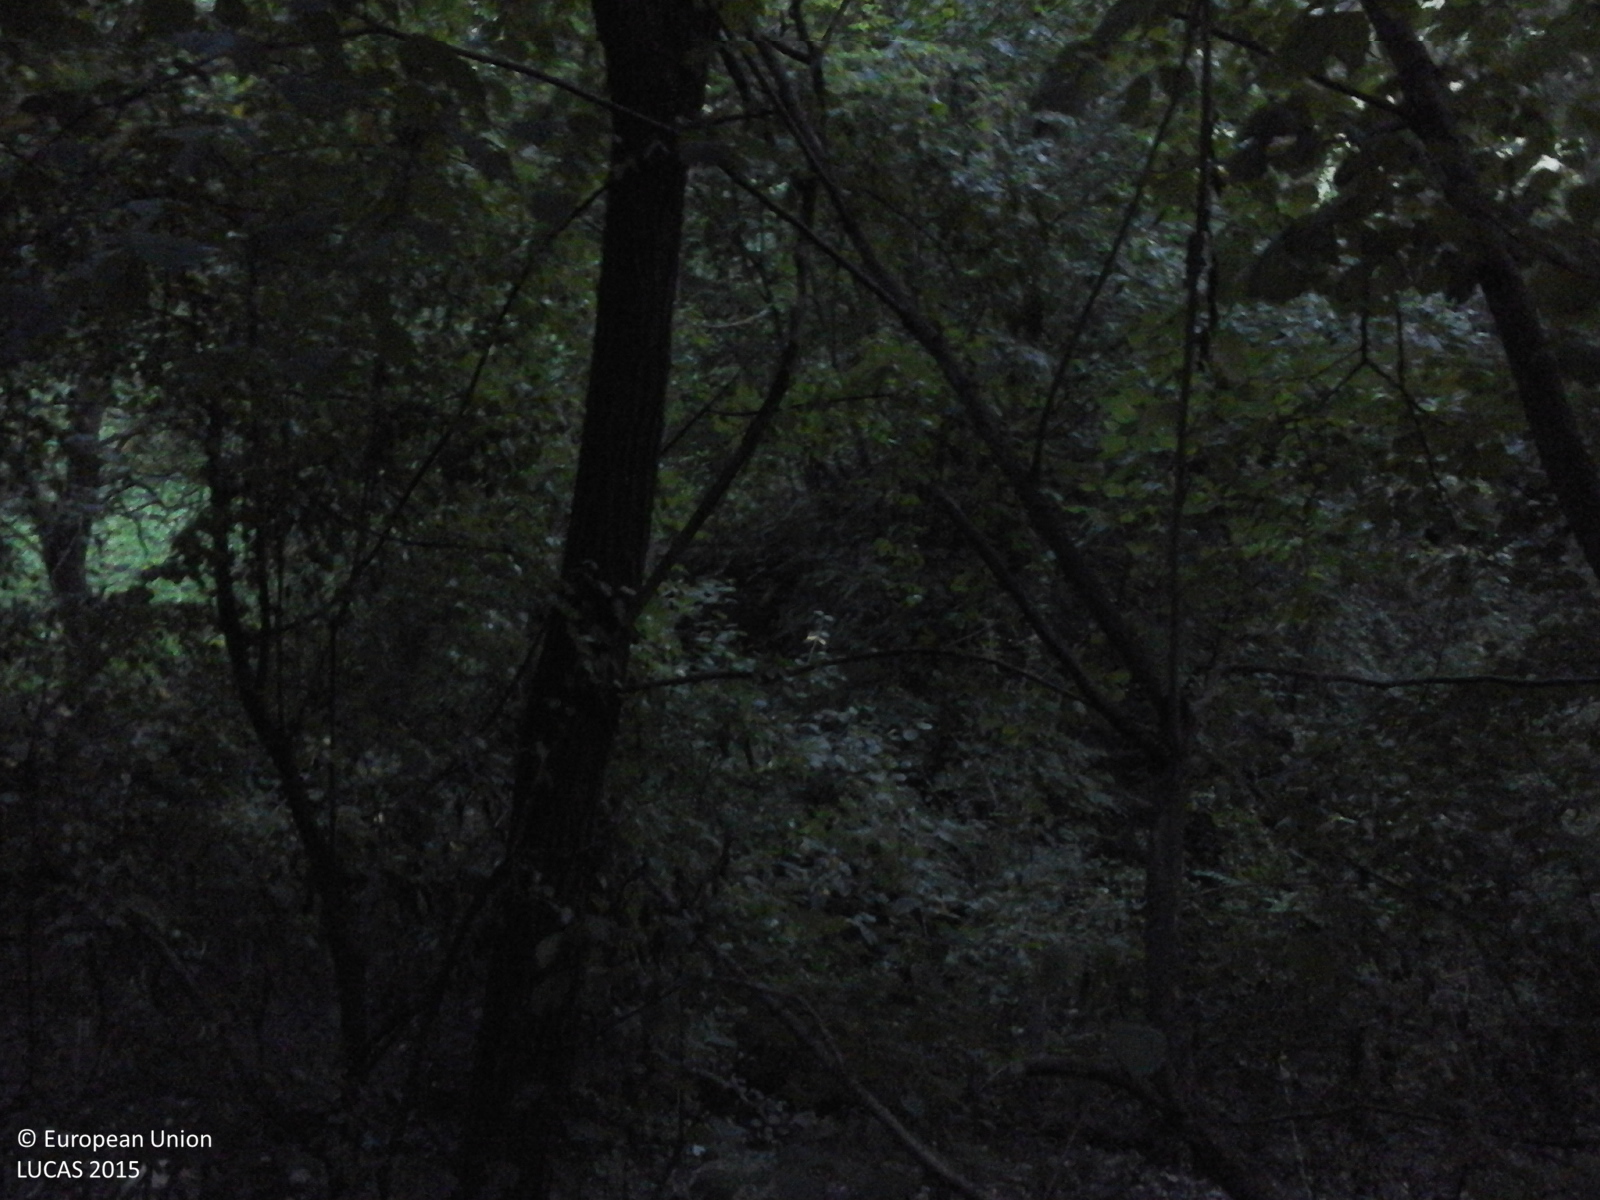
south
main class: Woodland
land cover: Broadleaved woodland
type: beech forest
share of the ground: > 75 %
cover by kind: broadleaved forest trees 100 %
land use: Forestry
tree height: > 5 m
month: September
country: RO
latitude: 47.2127
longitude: 23.4463
